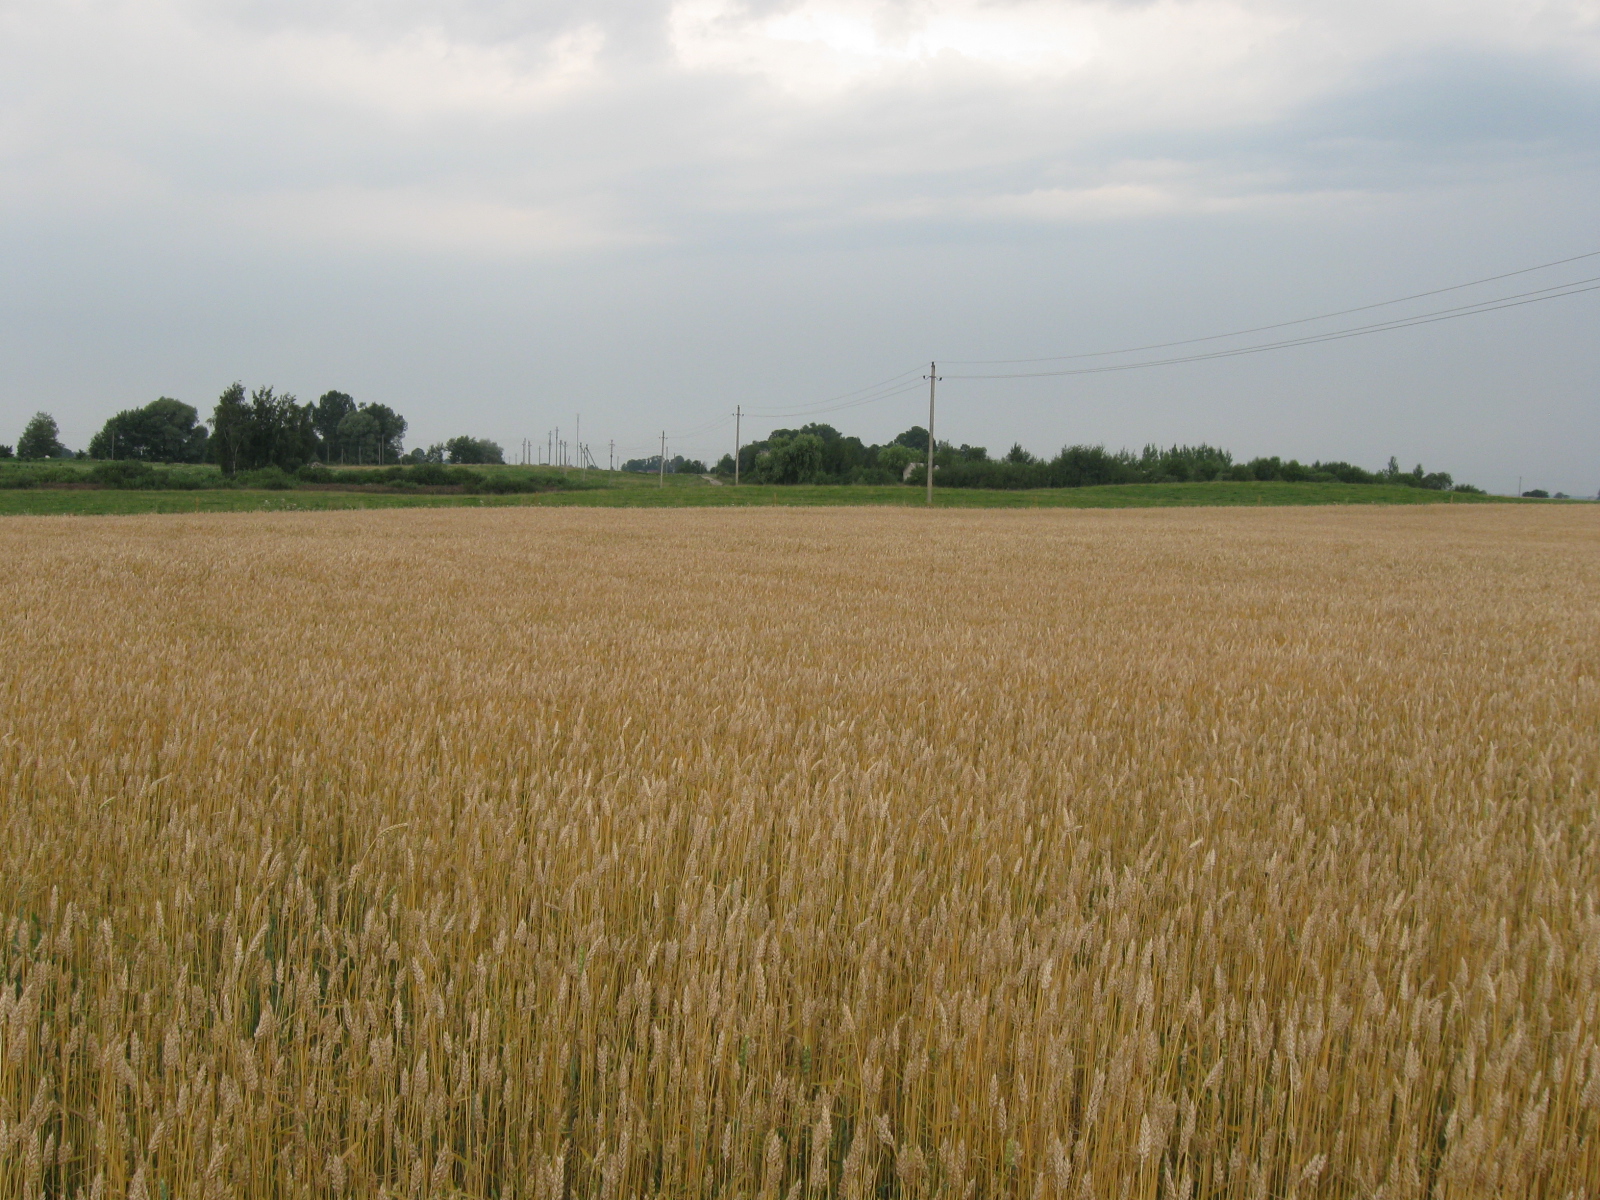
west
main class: Cropland
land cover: Common wheat
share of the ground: > 75 %
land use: Agriculture (excluding fallow land and kitchen gardens)
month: August
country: LT
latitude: 54.5585
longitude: 23.4884
